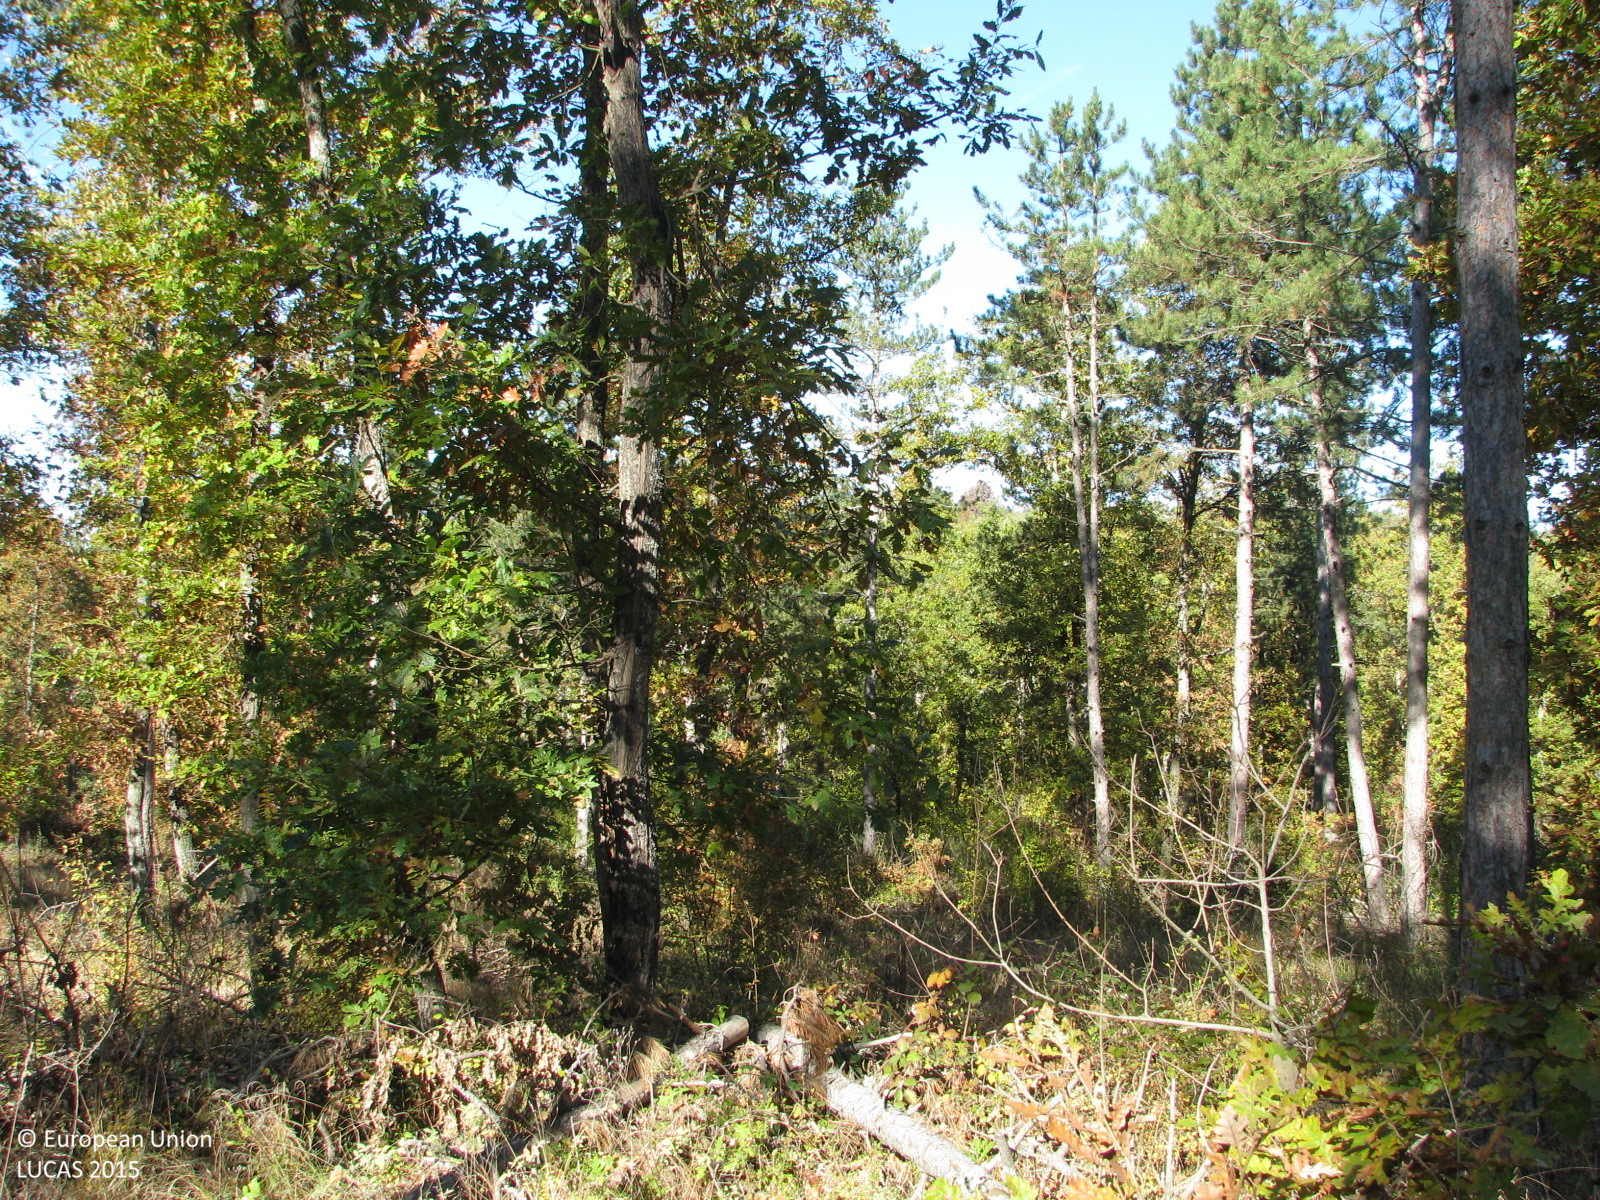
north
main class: Woodland
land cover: Pine dominated mixed woodland
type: hemiboreal forest and nemoral coniferous forest and mixed broadleaved-coniferous forest
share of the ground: 25 - 50 %
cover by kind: herbaceous plants 40 %, coniferous forest trees 30 %, broadleaved forest trees 20 %, shrubs 10 %
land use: Forestry
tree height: > 5 m
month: November
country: BG
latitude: 41.9901
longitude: 26.7123
